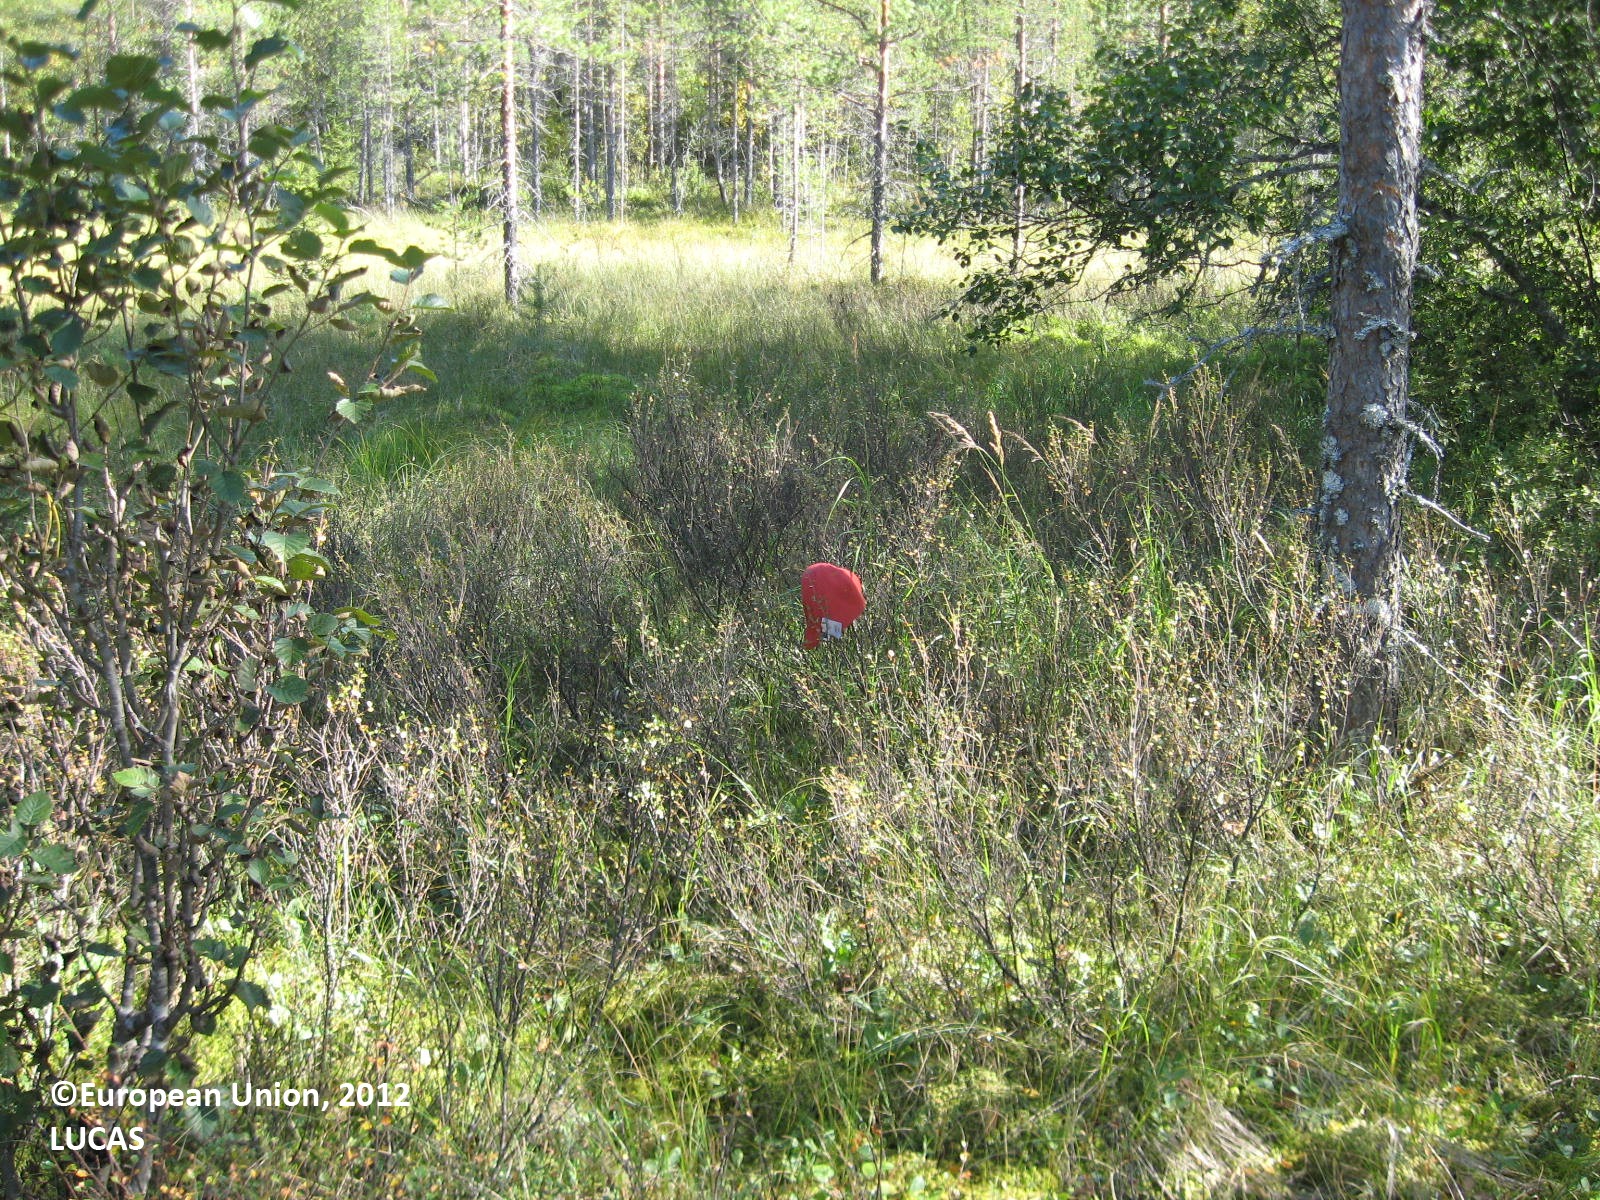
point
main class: Woodland
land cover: Pine dominated mixed woodland
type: boreal forest
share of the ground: 50 - 75 %
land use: Semi-natural and natural areas not in use
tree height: > 5 m
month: August
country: FI
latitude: 63.7713
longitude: 29.4683
